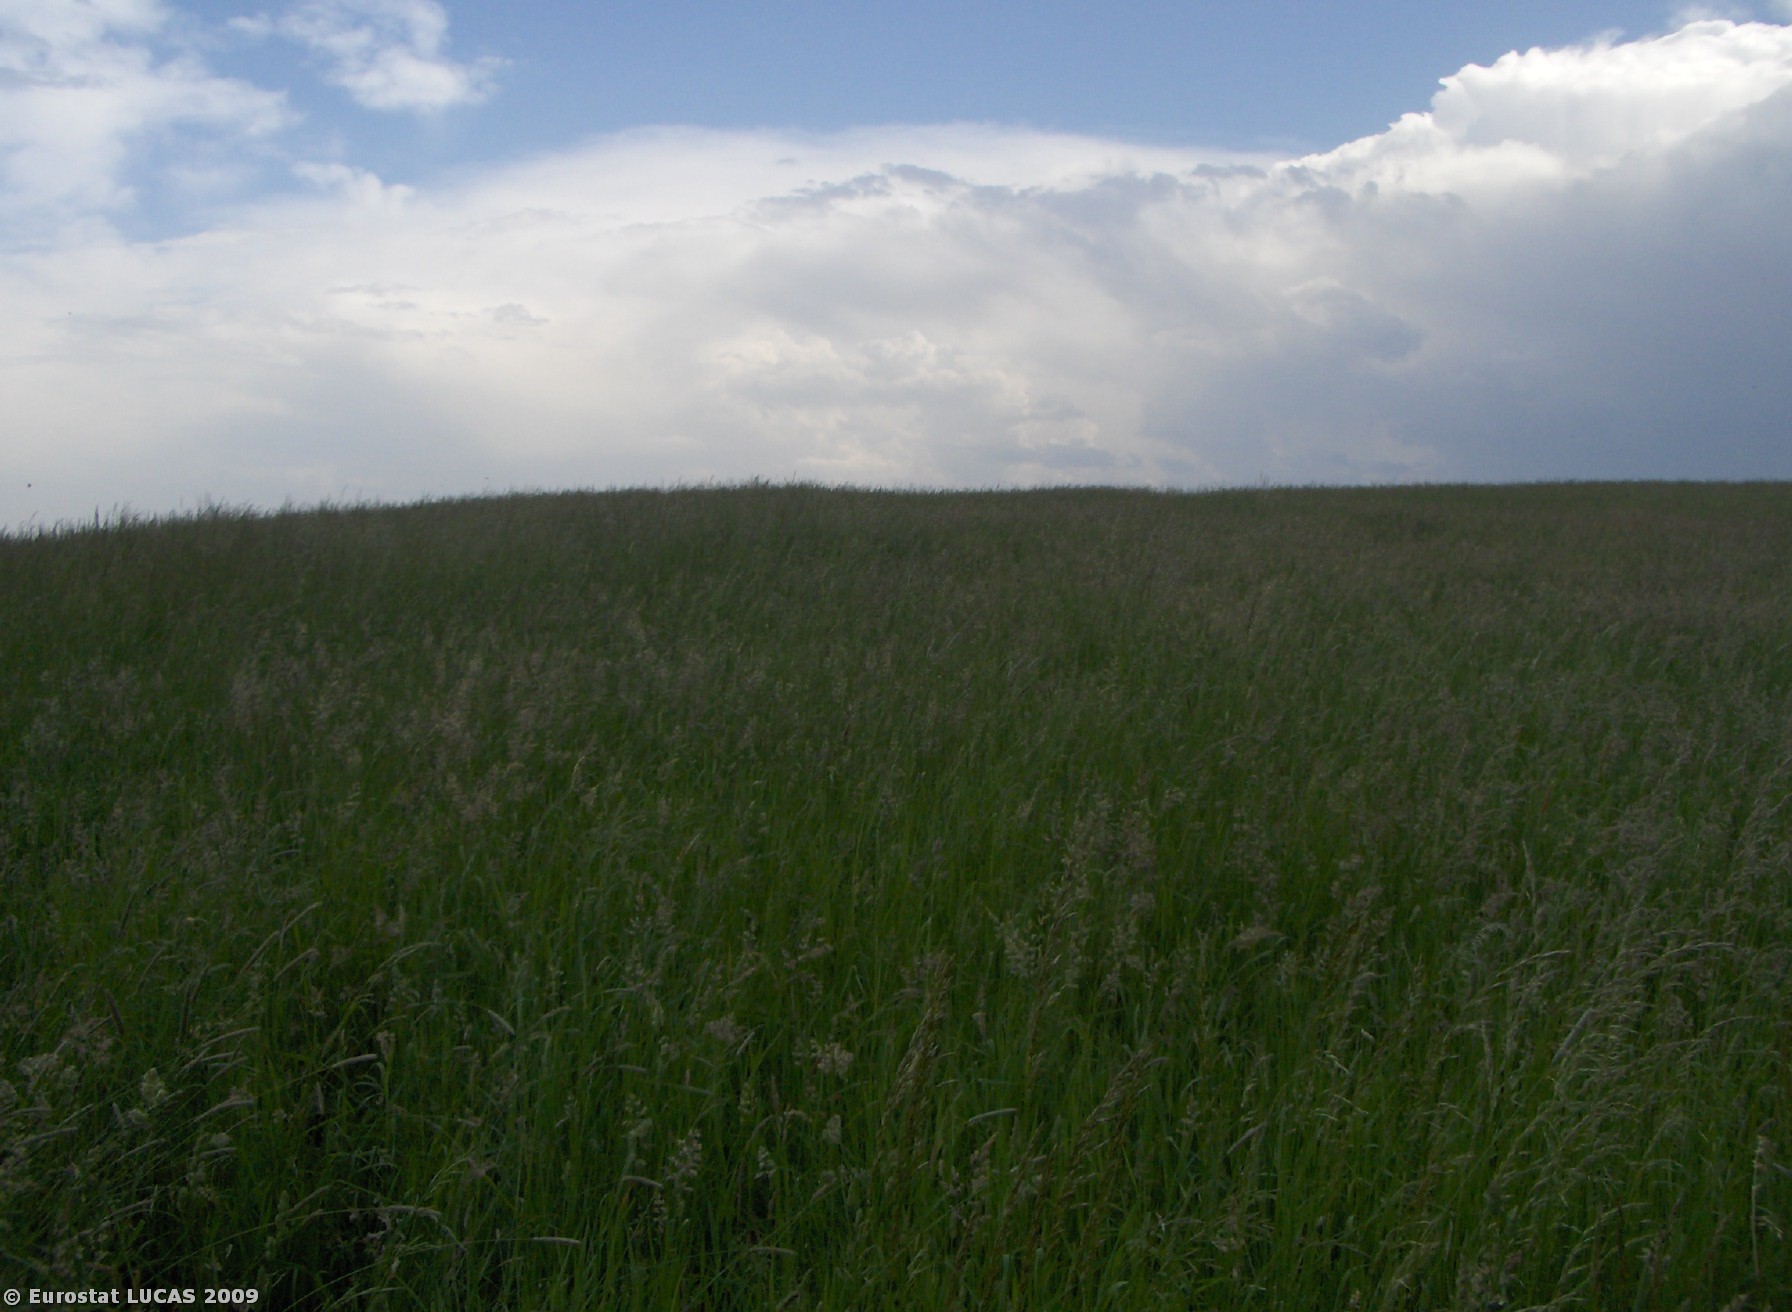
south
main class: Grassland
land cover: Grassland without tree/shrub cover
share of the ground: > 75 %
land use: Agriculture (excluding fallow land and kitchen gardens)
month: May
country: CZ
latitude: 49.1561
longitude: 14.5674
